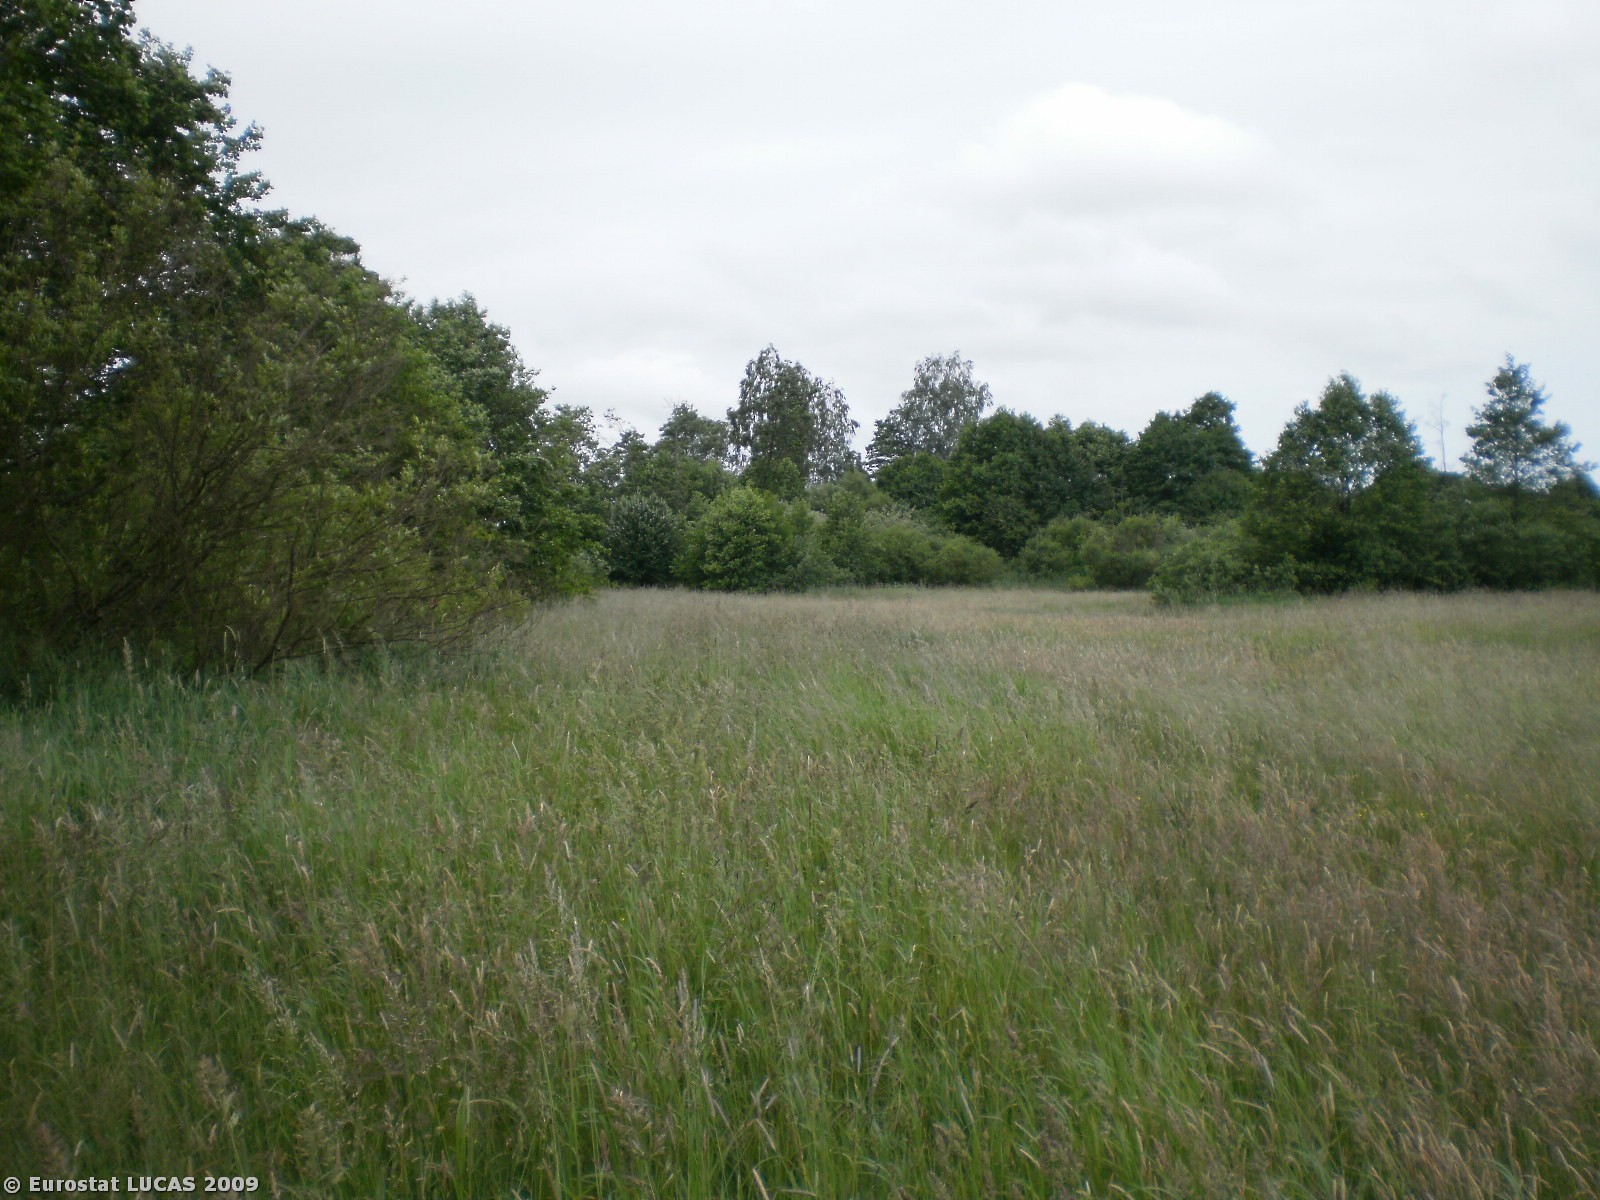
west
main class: Grassland
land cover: Grassland without tree/shrub cover
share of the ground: > 75 %
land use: Agriculture (excluding fallow land and kitchen gardens)
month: June
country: PL
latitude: 54.5896
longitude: 17.8895
